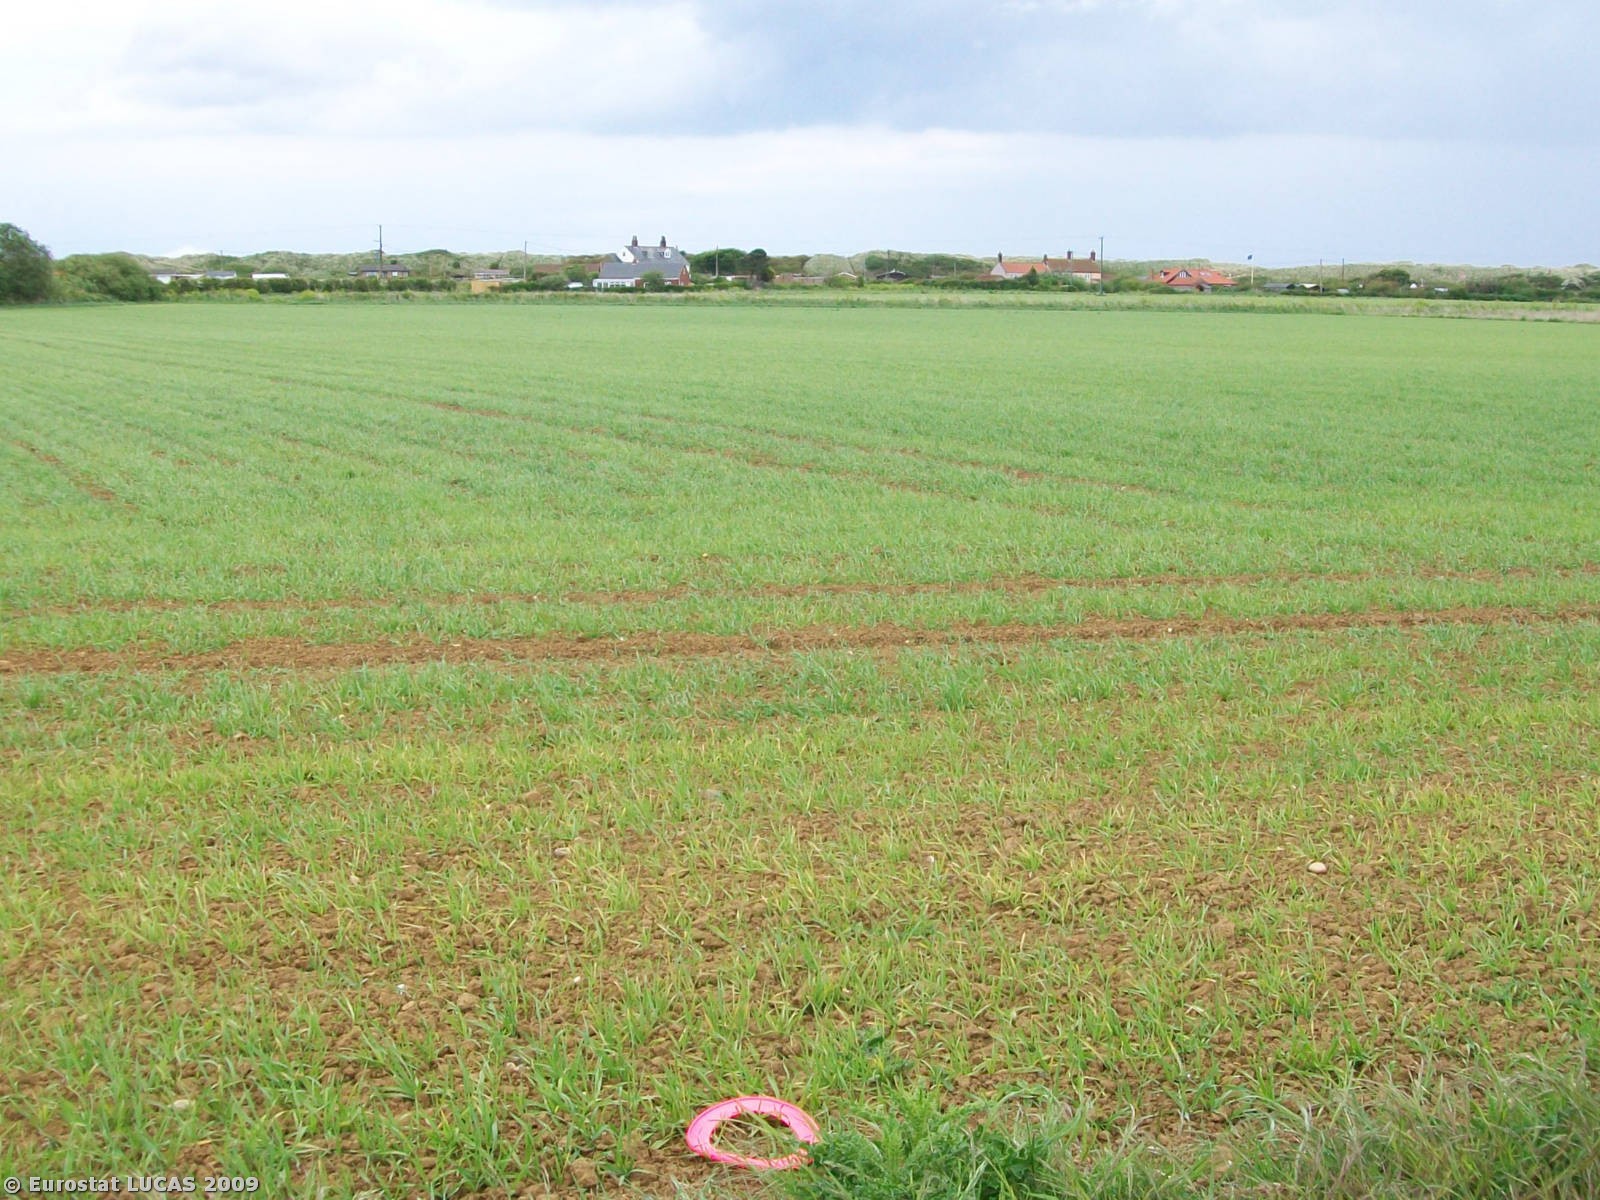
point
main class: Cropland
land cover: Common wheat
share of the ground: 25 - 50 %
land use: Agriculture (excluding fallow land and kitchen gardens)
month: May
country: GB
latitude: 52.8005
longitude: 1.5718
